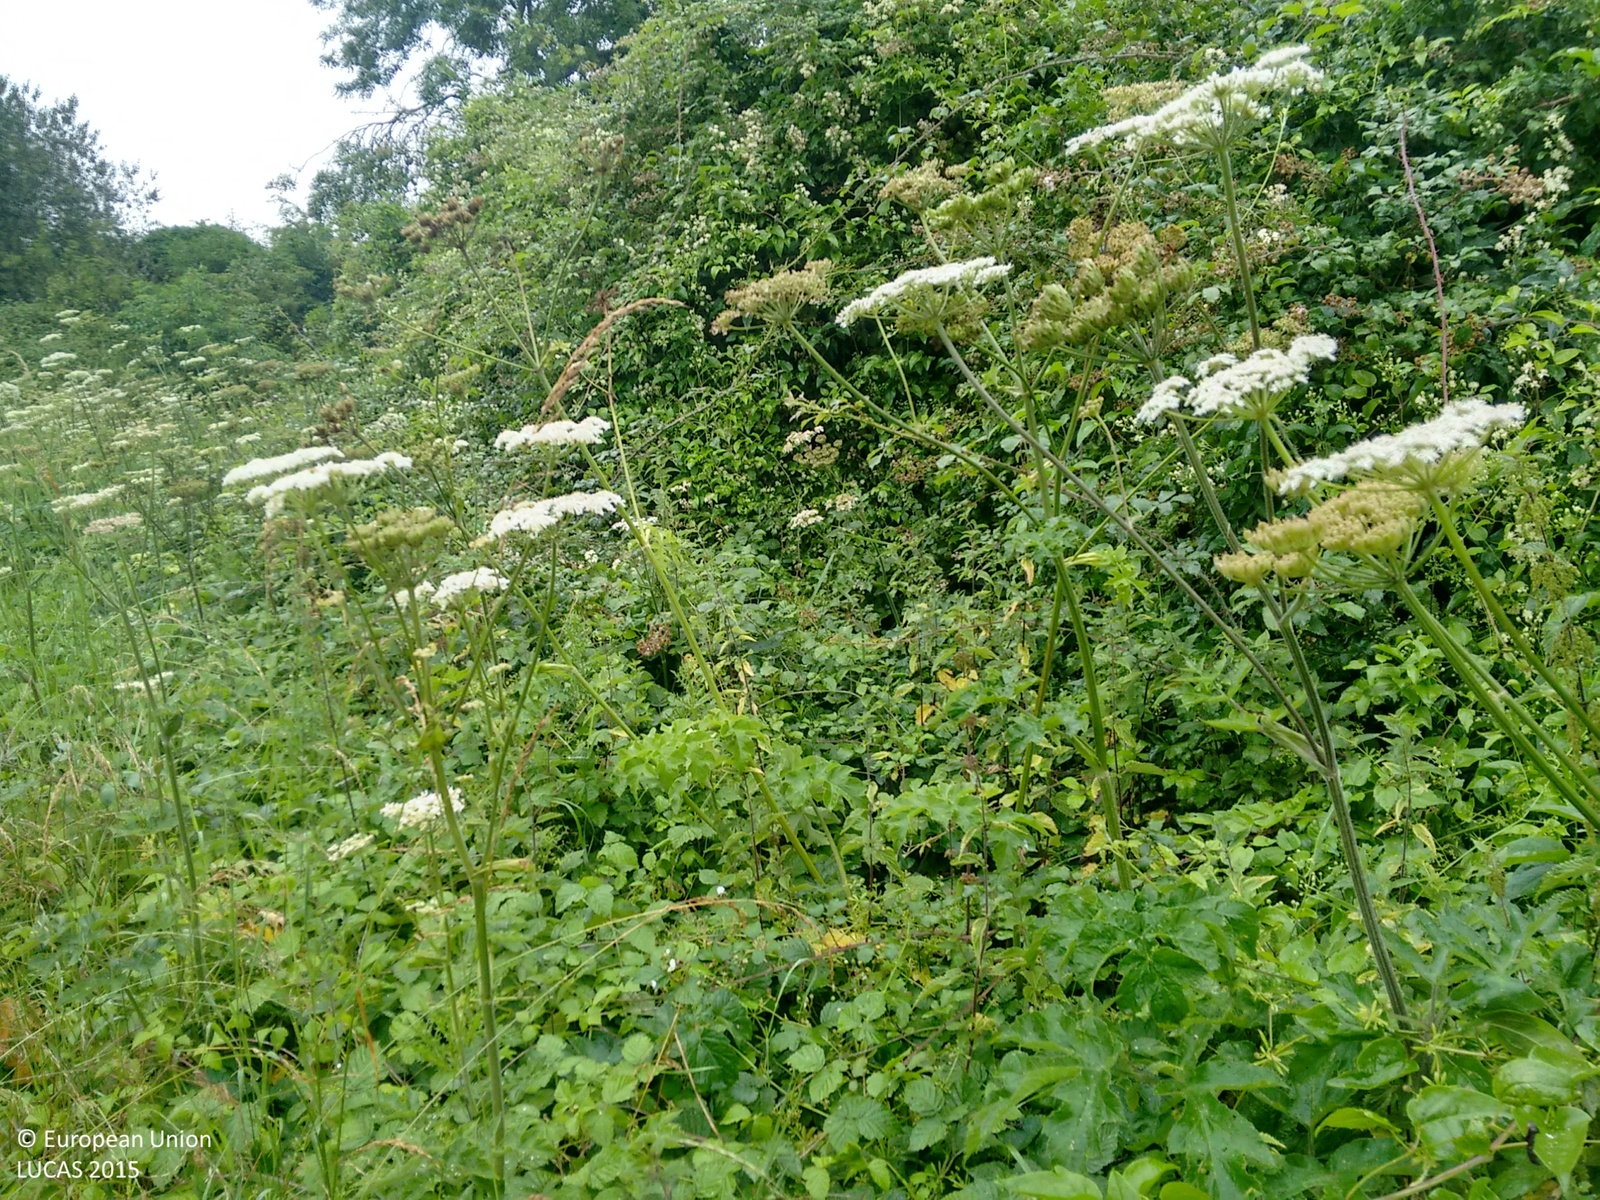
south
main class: Woodland
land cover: Broadleaved woodland
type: mesophytic deciduous forest
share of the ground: > 75 %
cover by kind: broadleaved forest trees 100 %
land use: Agriculture (excluding fallow land and kitchen gardens)
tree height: > 5 m
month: July
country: GB
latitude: 51.0411
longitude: -1.0701
